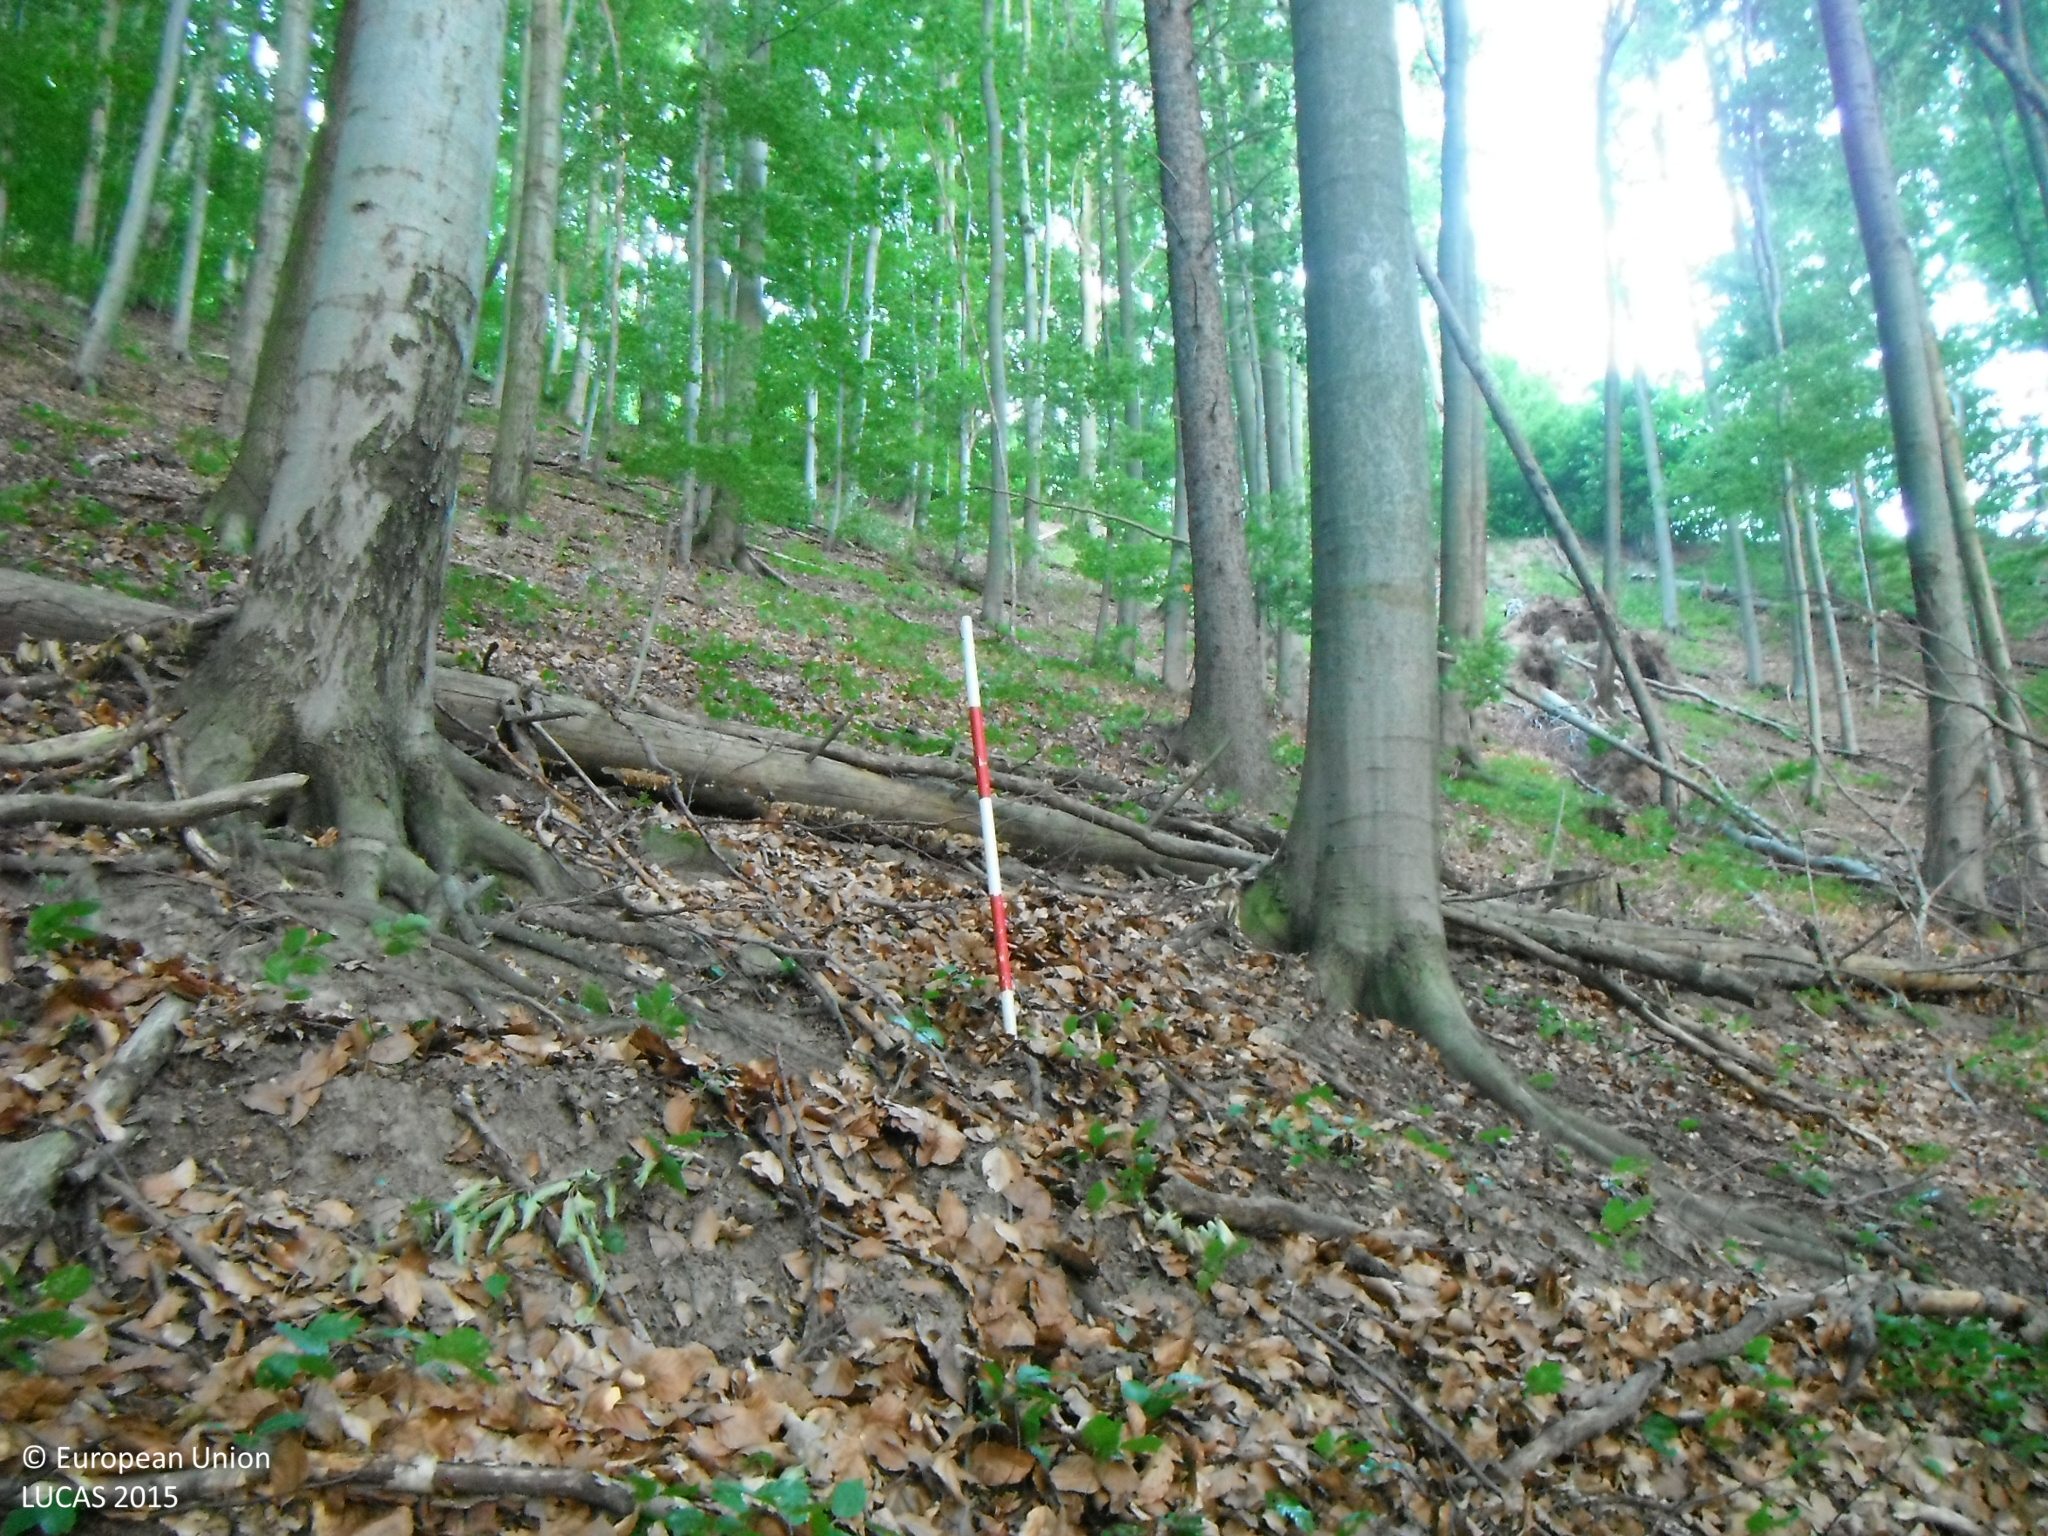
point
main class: Woodland
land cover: Broadleaved woodland
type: beech forest
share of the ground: > 75 %
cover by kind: broadleaved forest trees 100 %
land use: Forestry
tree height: > 5 m
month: July
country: SK
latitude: 48.5470
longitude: 18.9473
